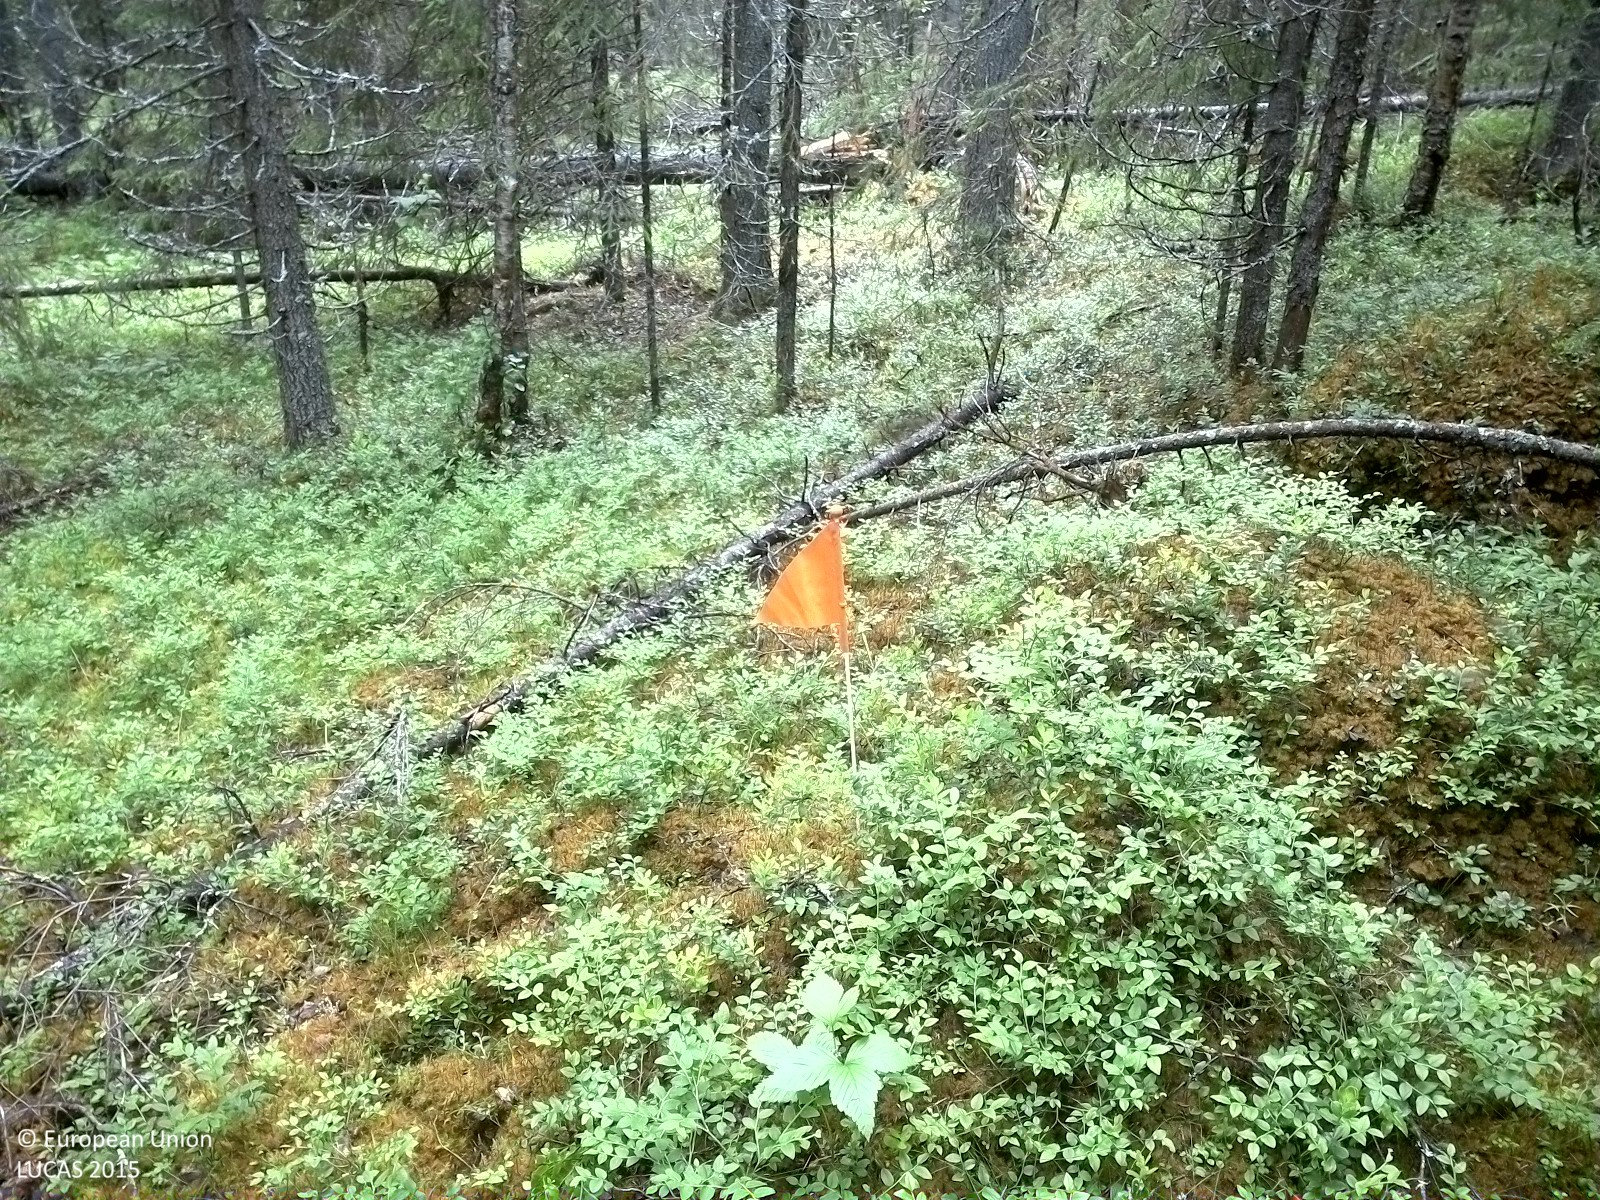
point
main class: Woodland
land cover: Spruce dominated coniferous woodland
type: boreal forest
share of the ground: > 75 %
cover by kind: coniferous forest trees 80 %, shrubs 15 %, broadleaved forest trees 5 %
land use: Forestry
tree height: > 5 m
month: July
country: SE
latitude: 63.5674
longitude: 15.3111
